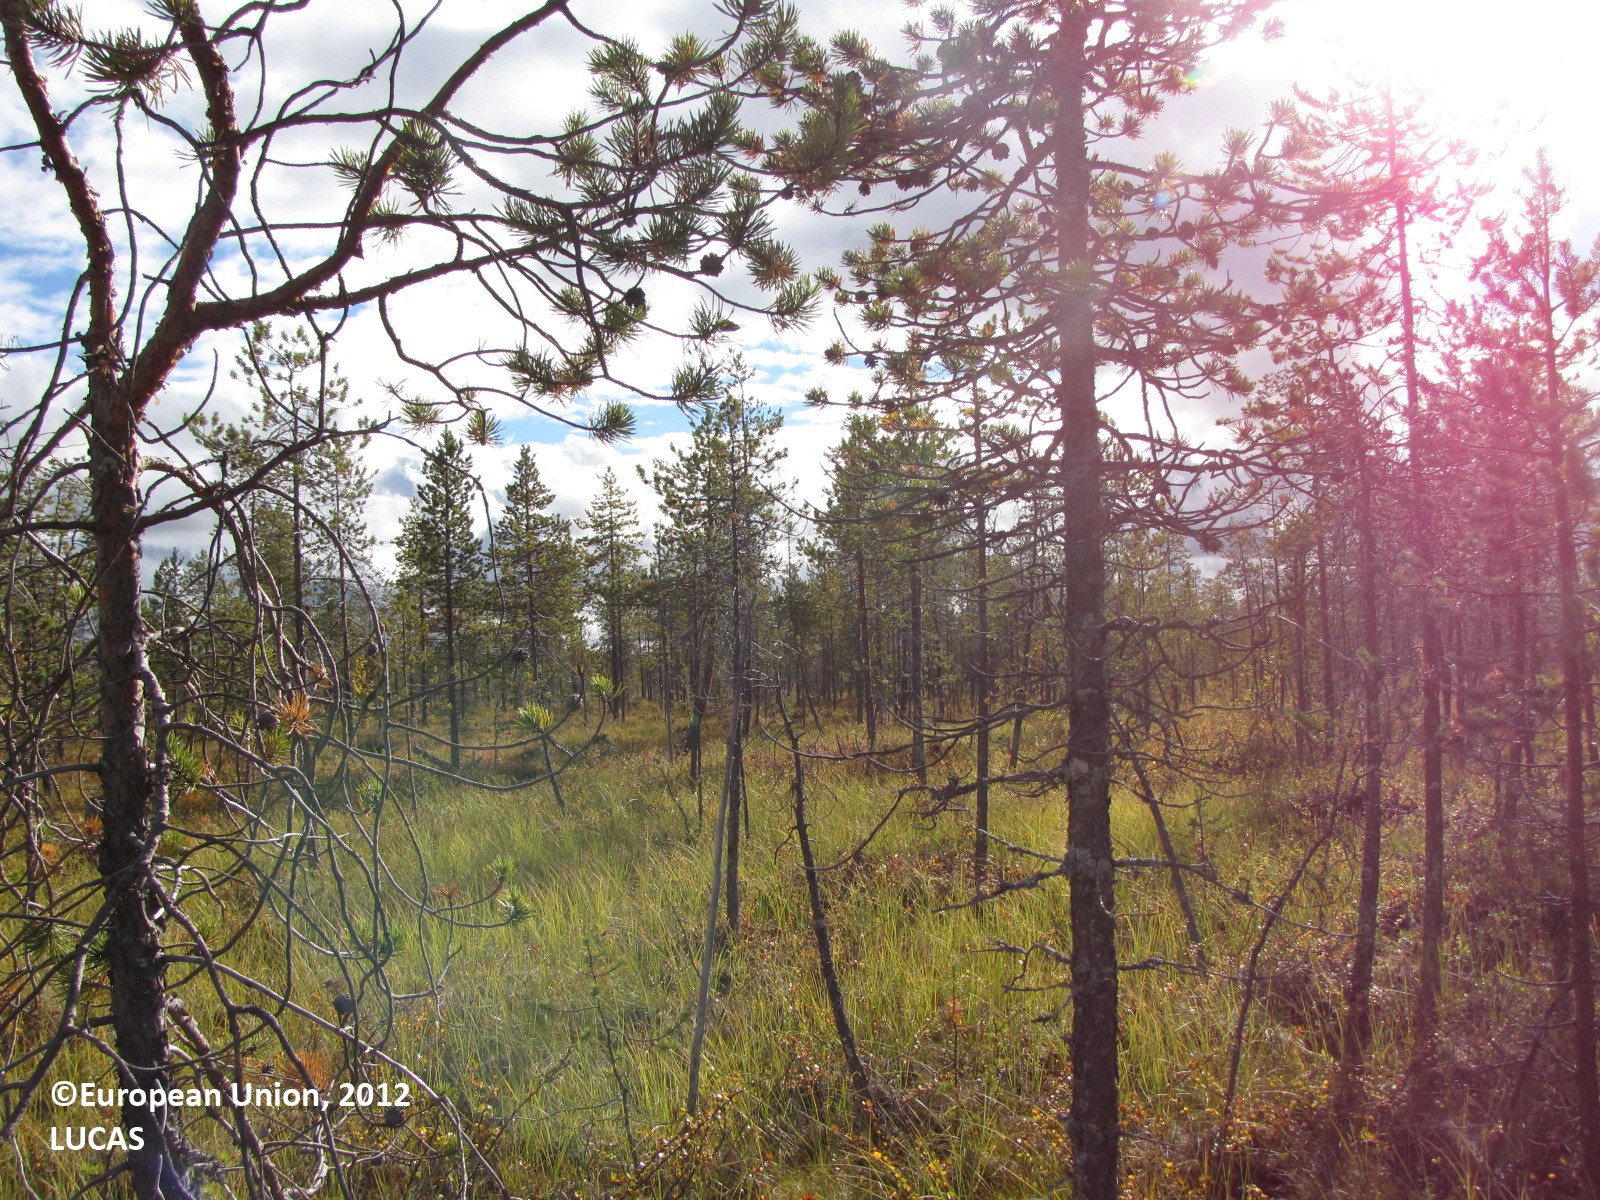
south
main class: Woodland
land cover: Pine dominated coniferous woodland
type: boreal forest
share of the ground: 25 - 50 %
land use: Forestry
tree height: > 5 m
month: September
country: FI
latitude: 67.3882
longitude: 24.8854
